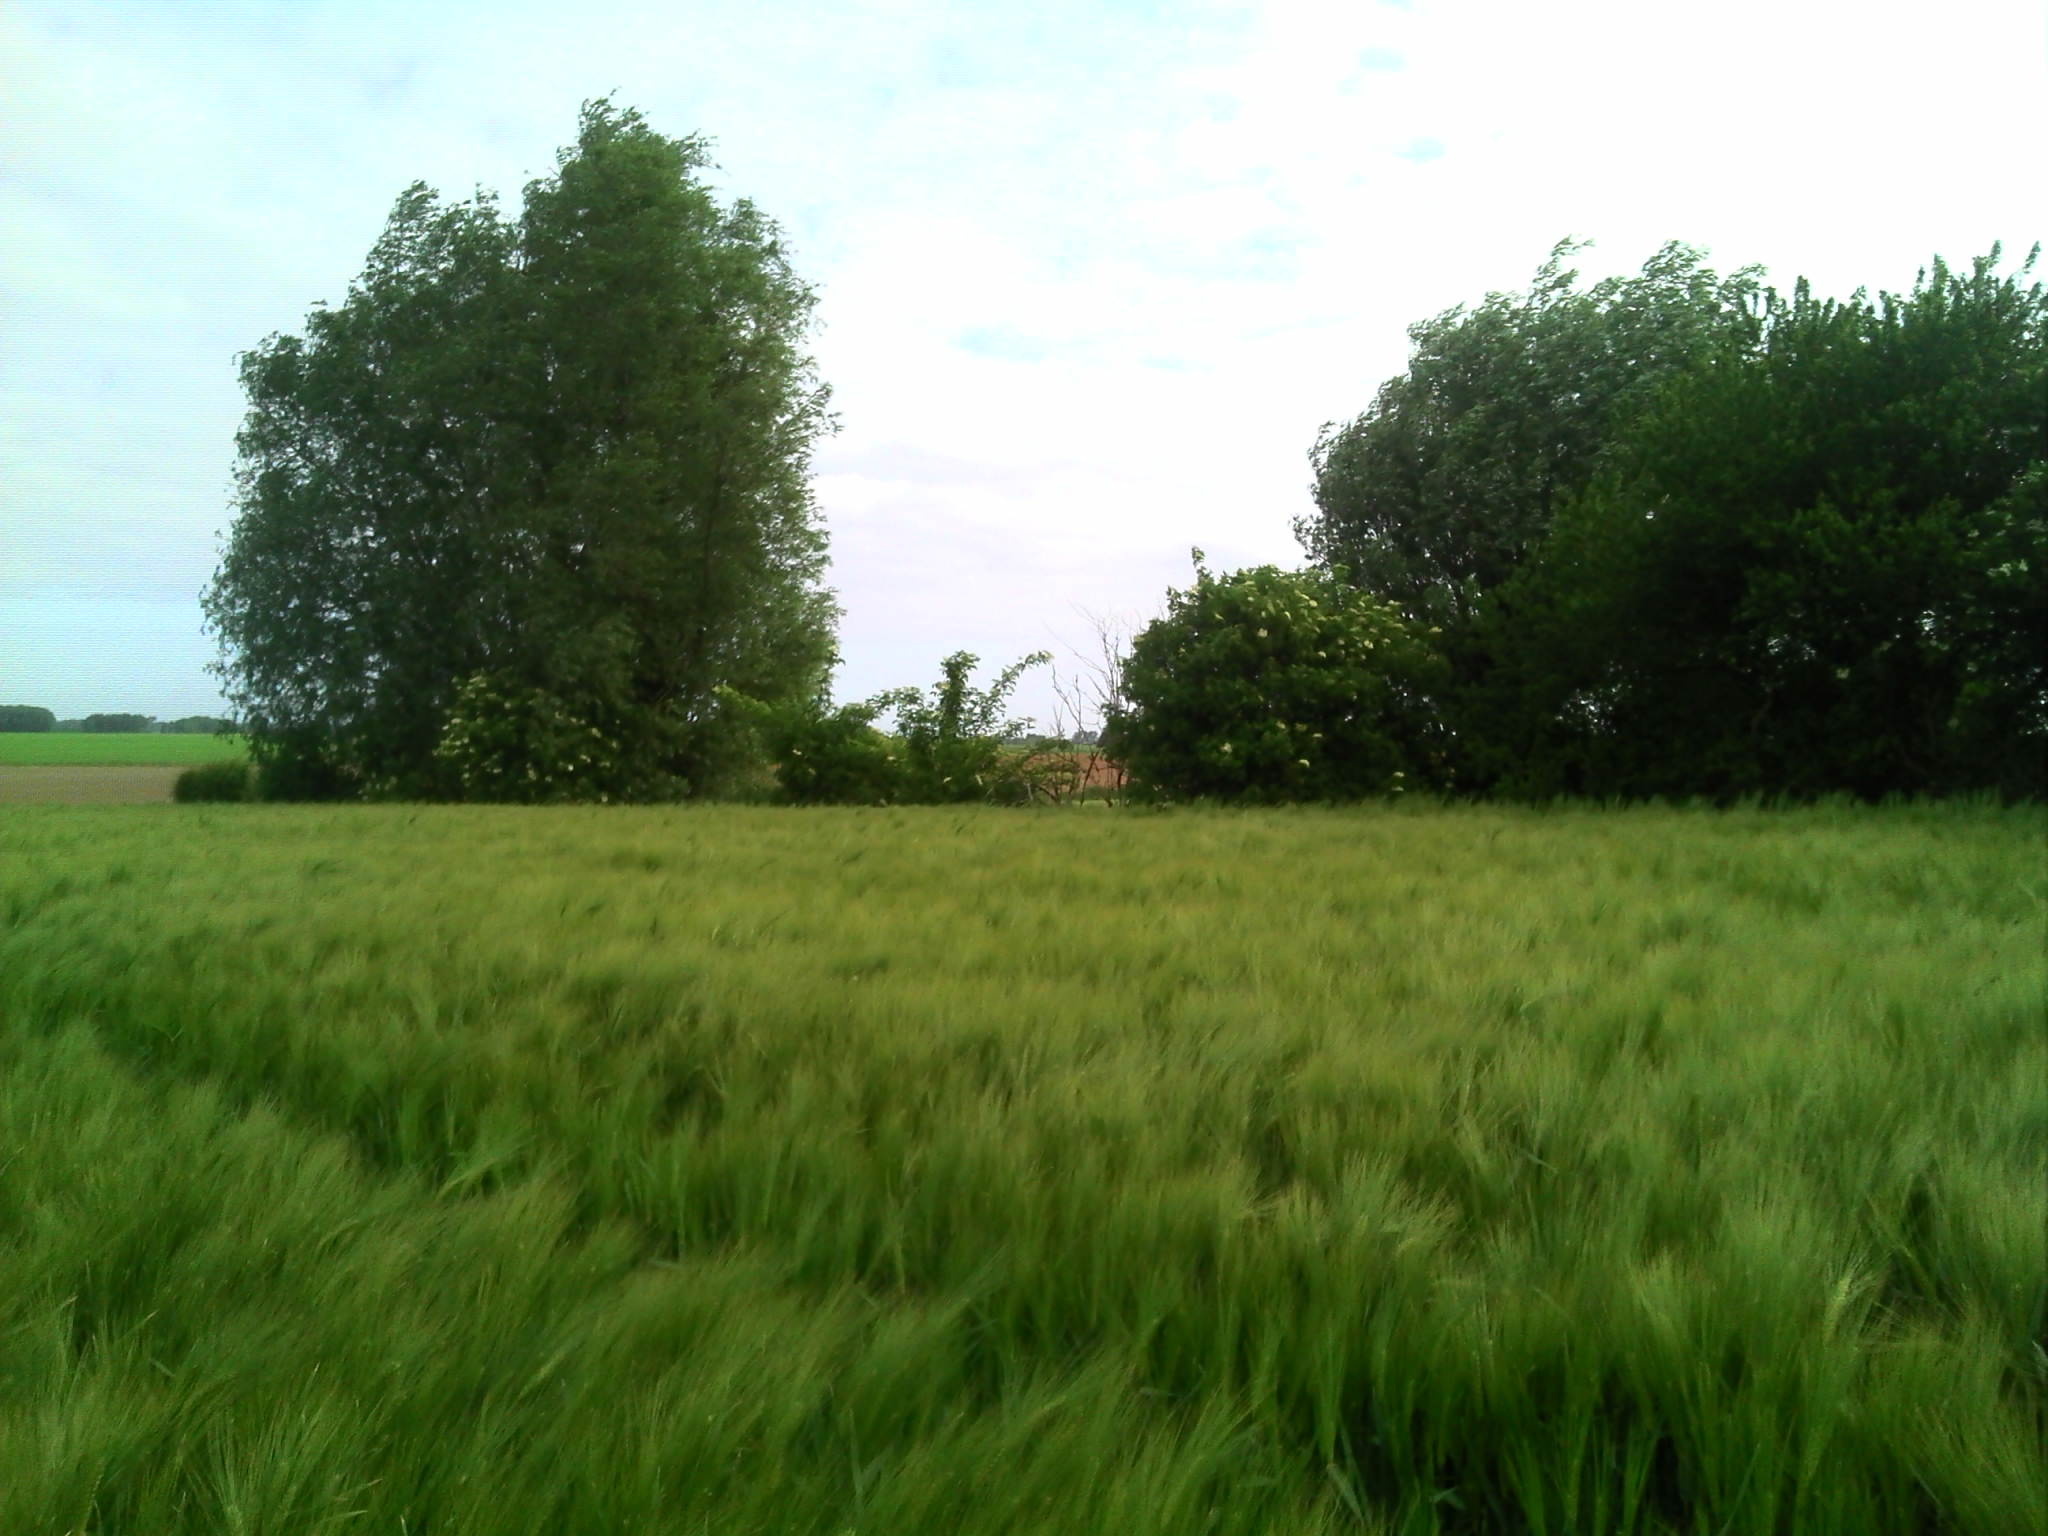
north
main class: Cropland
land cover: Barley
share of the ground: > 75 %
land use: Agriculture (excluding fallow land and kitchen gardens)
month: June
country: BE
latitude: 50.5425
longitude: 4.5916
